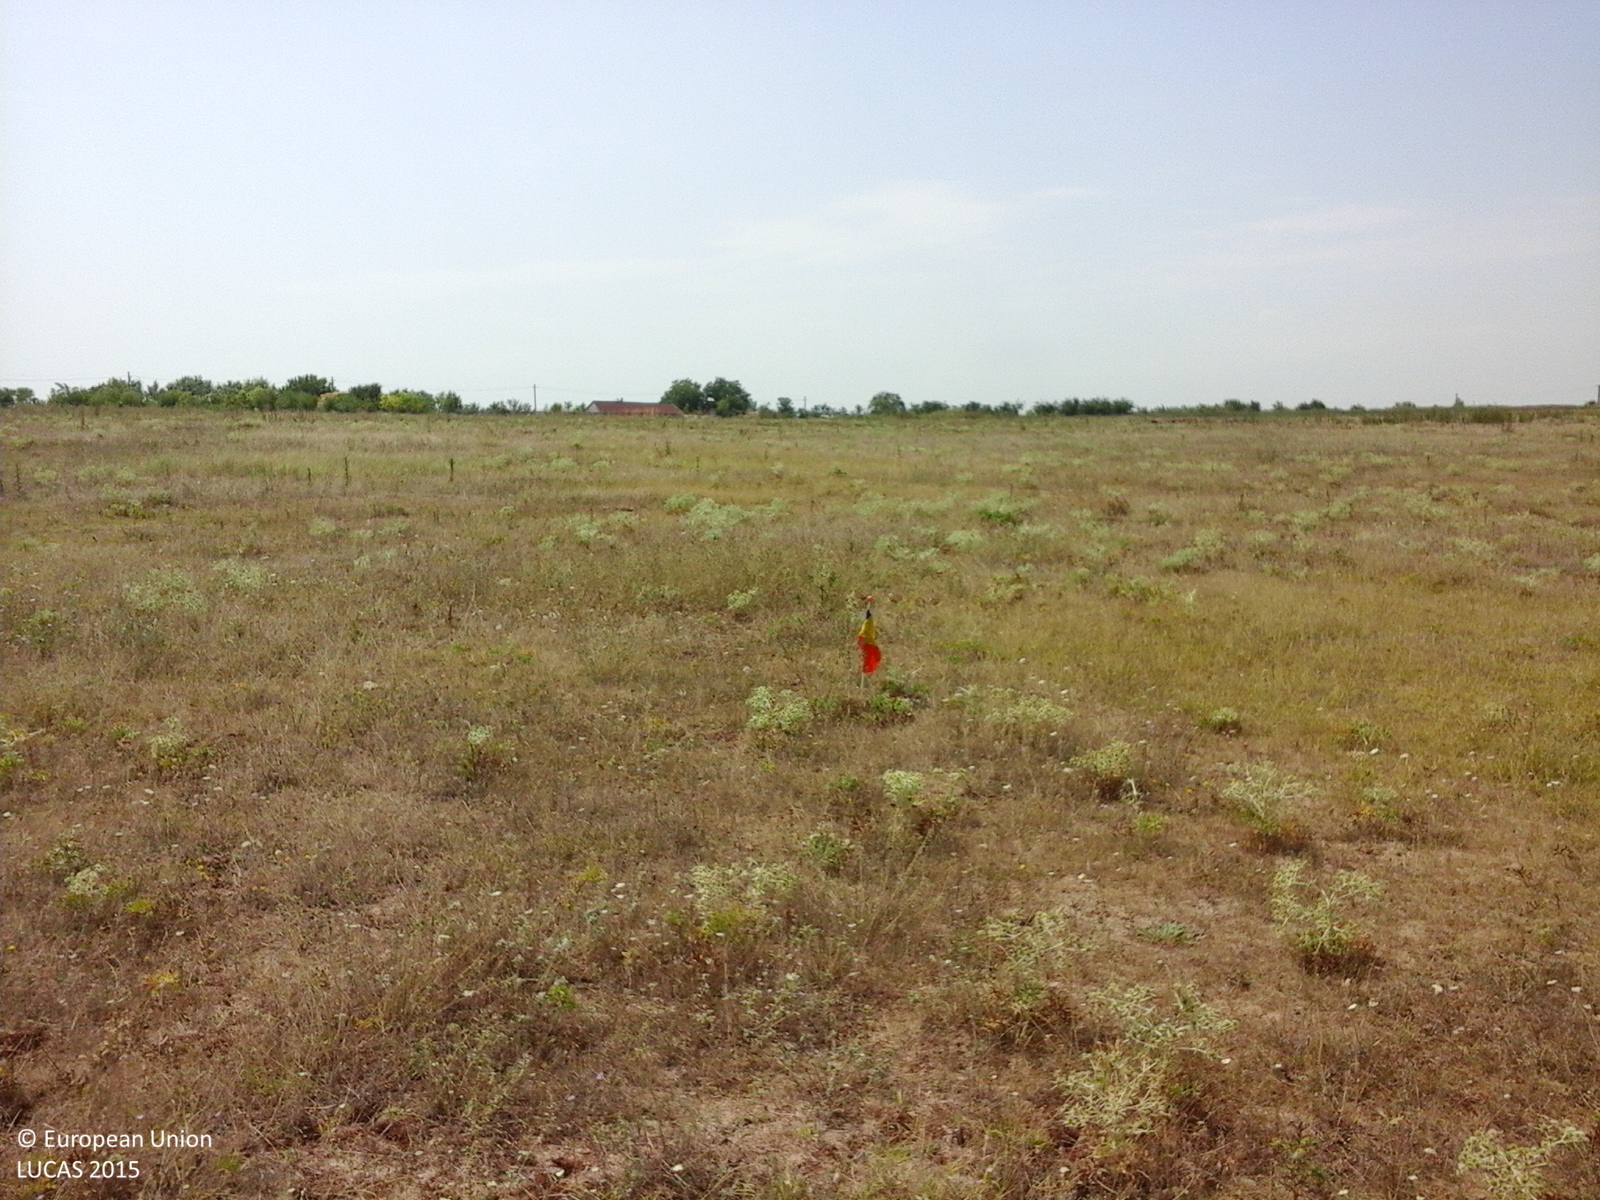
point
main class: Grassland
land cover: Spontaneously vegetated surfaces
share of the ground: > 75 %
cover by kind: herbaceous plants 100 %
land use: Fallow land
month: August
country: RO
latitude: 43.7879
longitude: 28.3400
